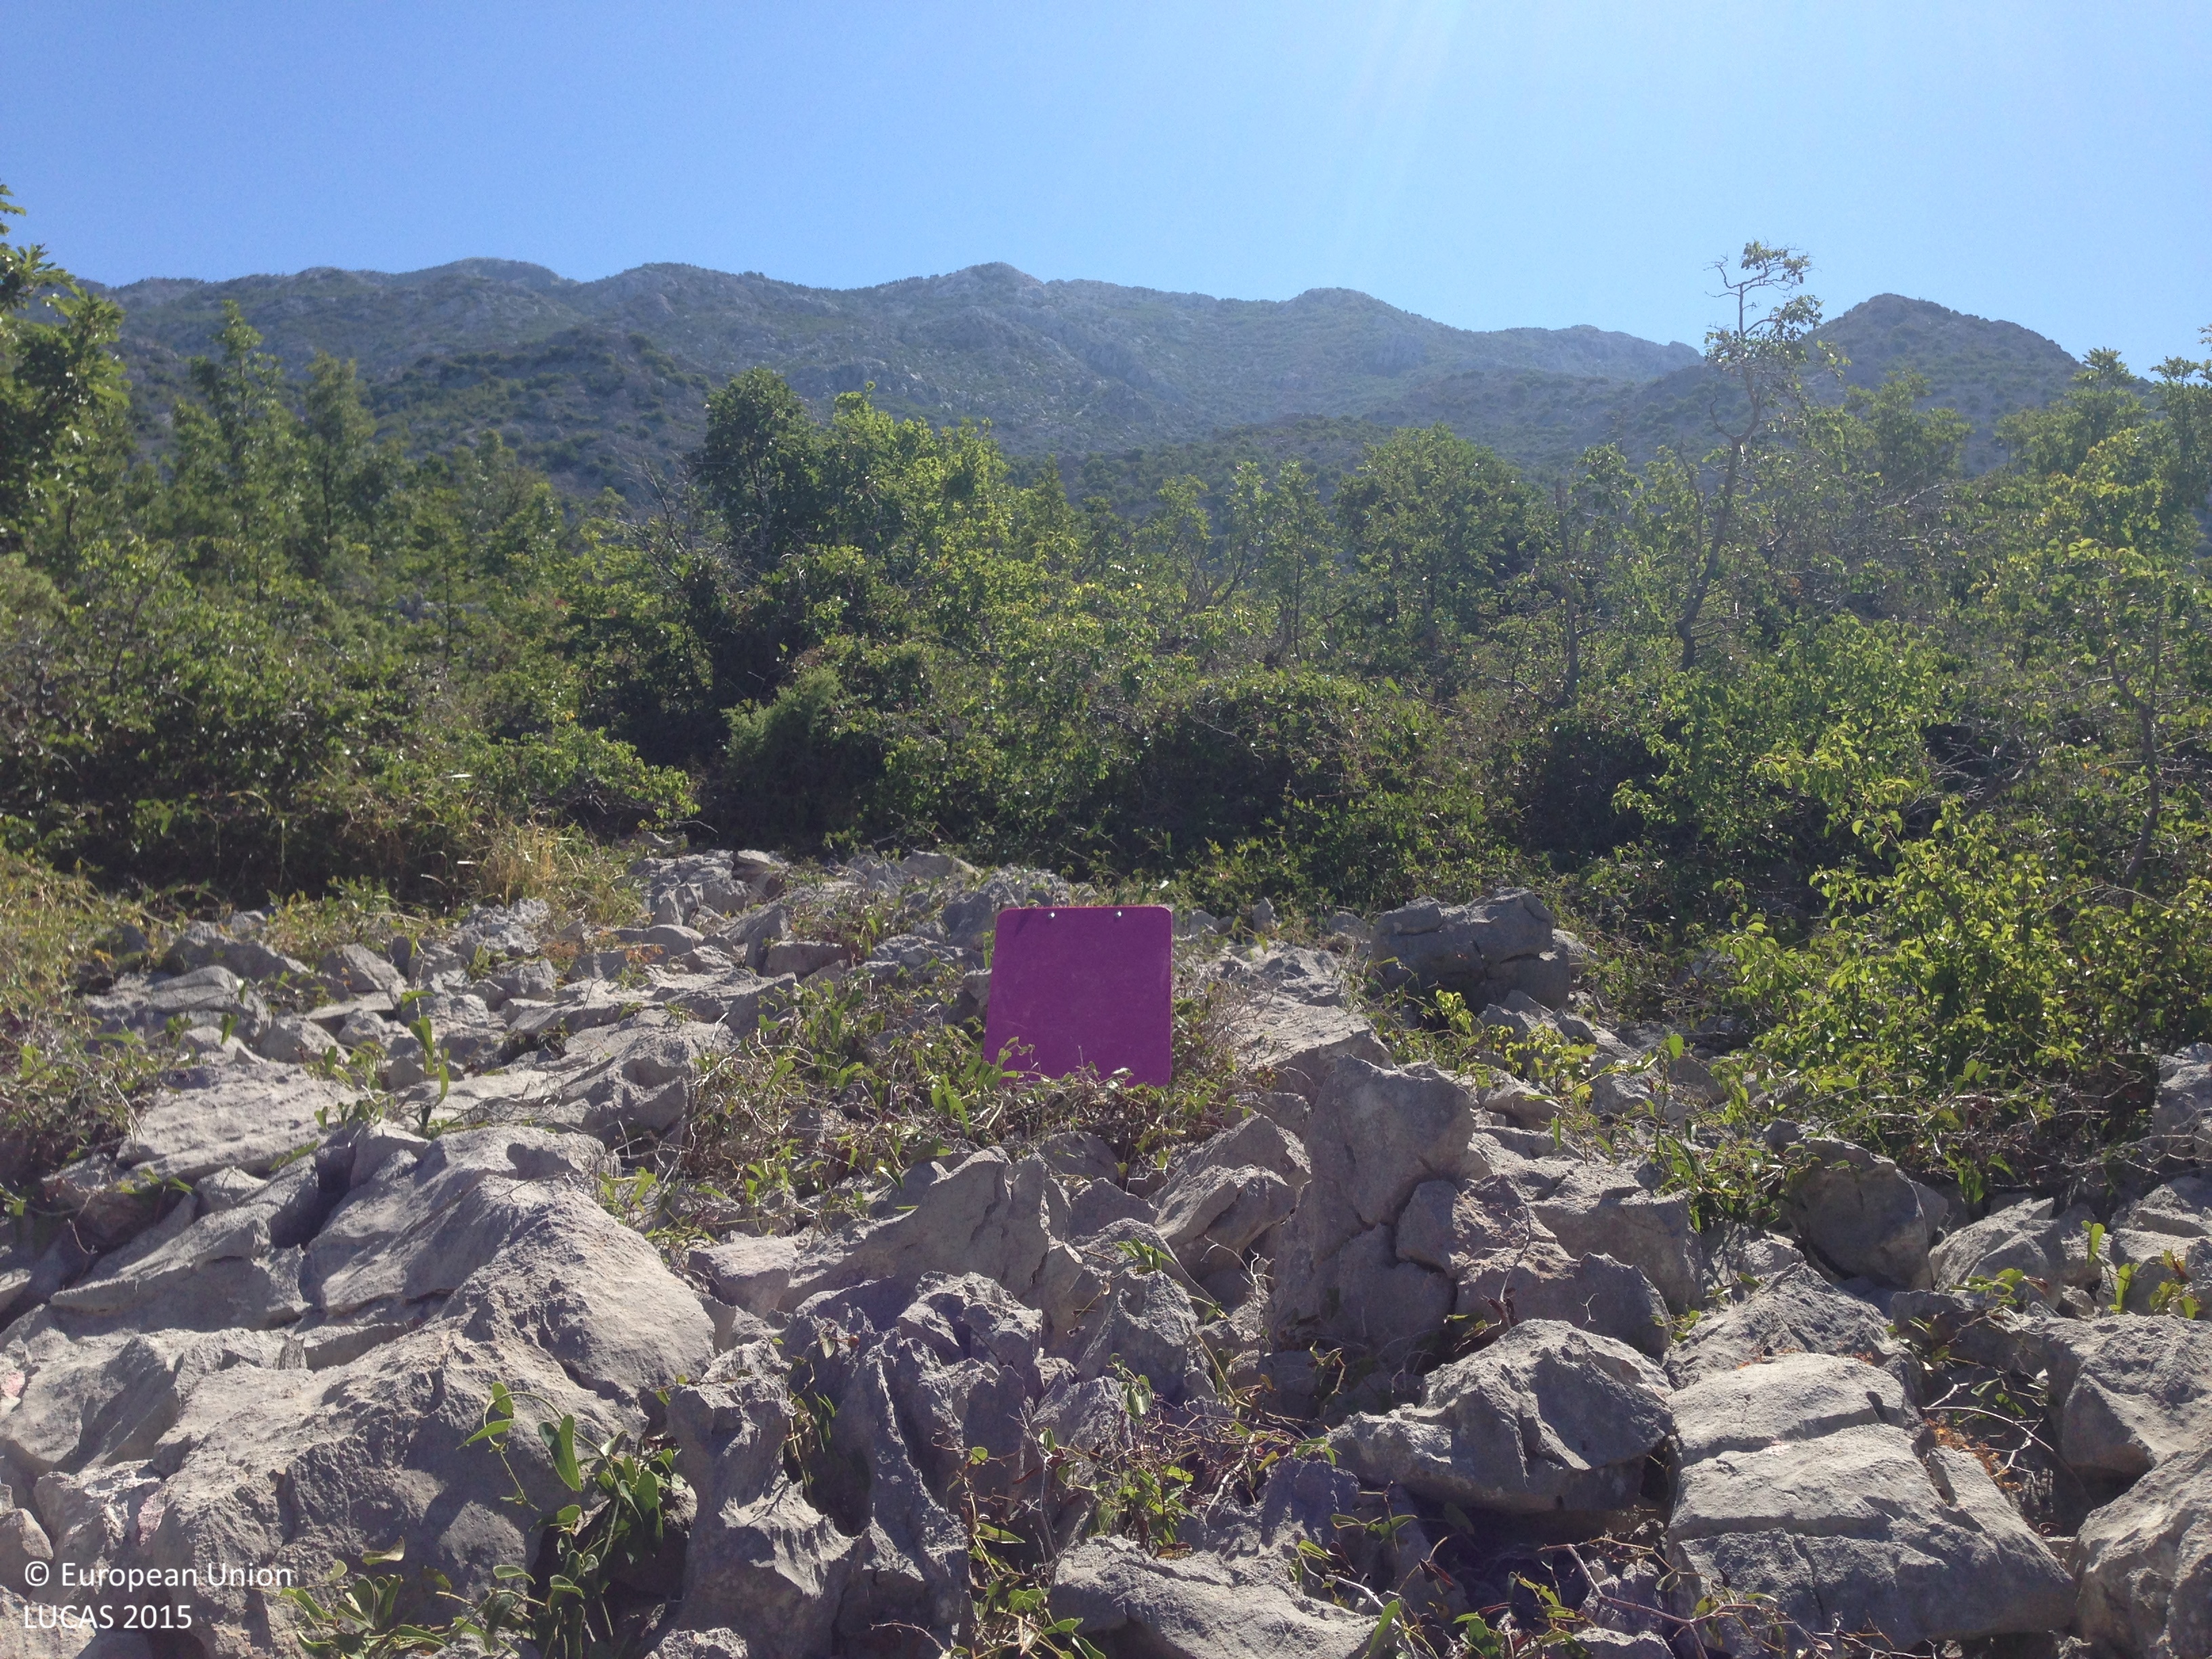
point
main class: Woodland
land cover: Broadleaved woodland
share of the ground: 25 - 50 %
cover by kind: consolidated bare surface 30 %, broadleaved forest trees 25 %, shrubs 25 %, herbaceous plants 10 %, unconsolidated bare surface 10 %
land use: Semi-natural and natural areas not in use
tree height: < 5 m
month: July
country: HR
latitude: 44.7403
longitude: 14.9063
